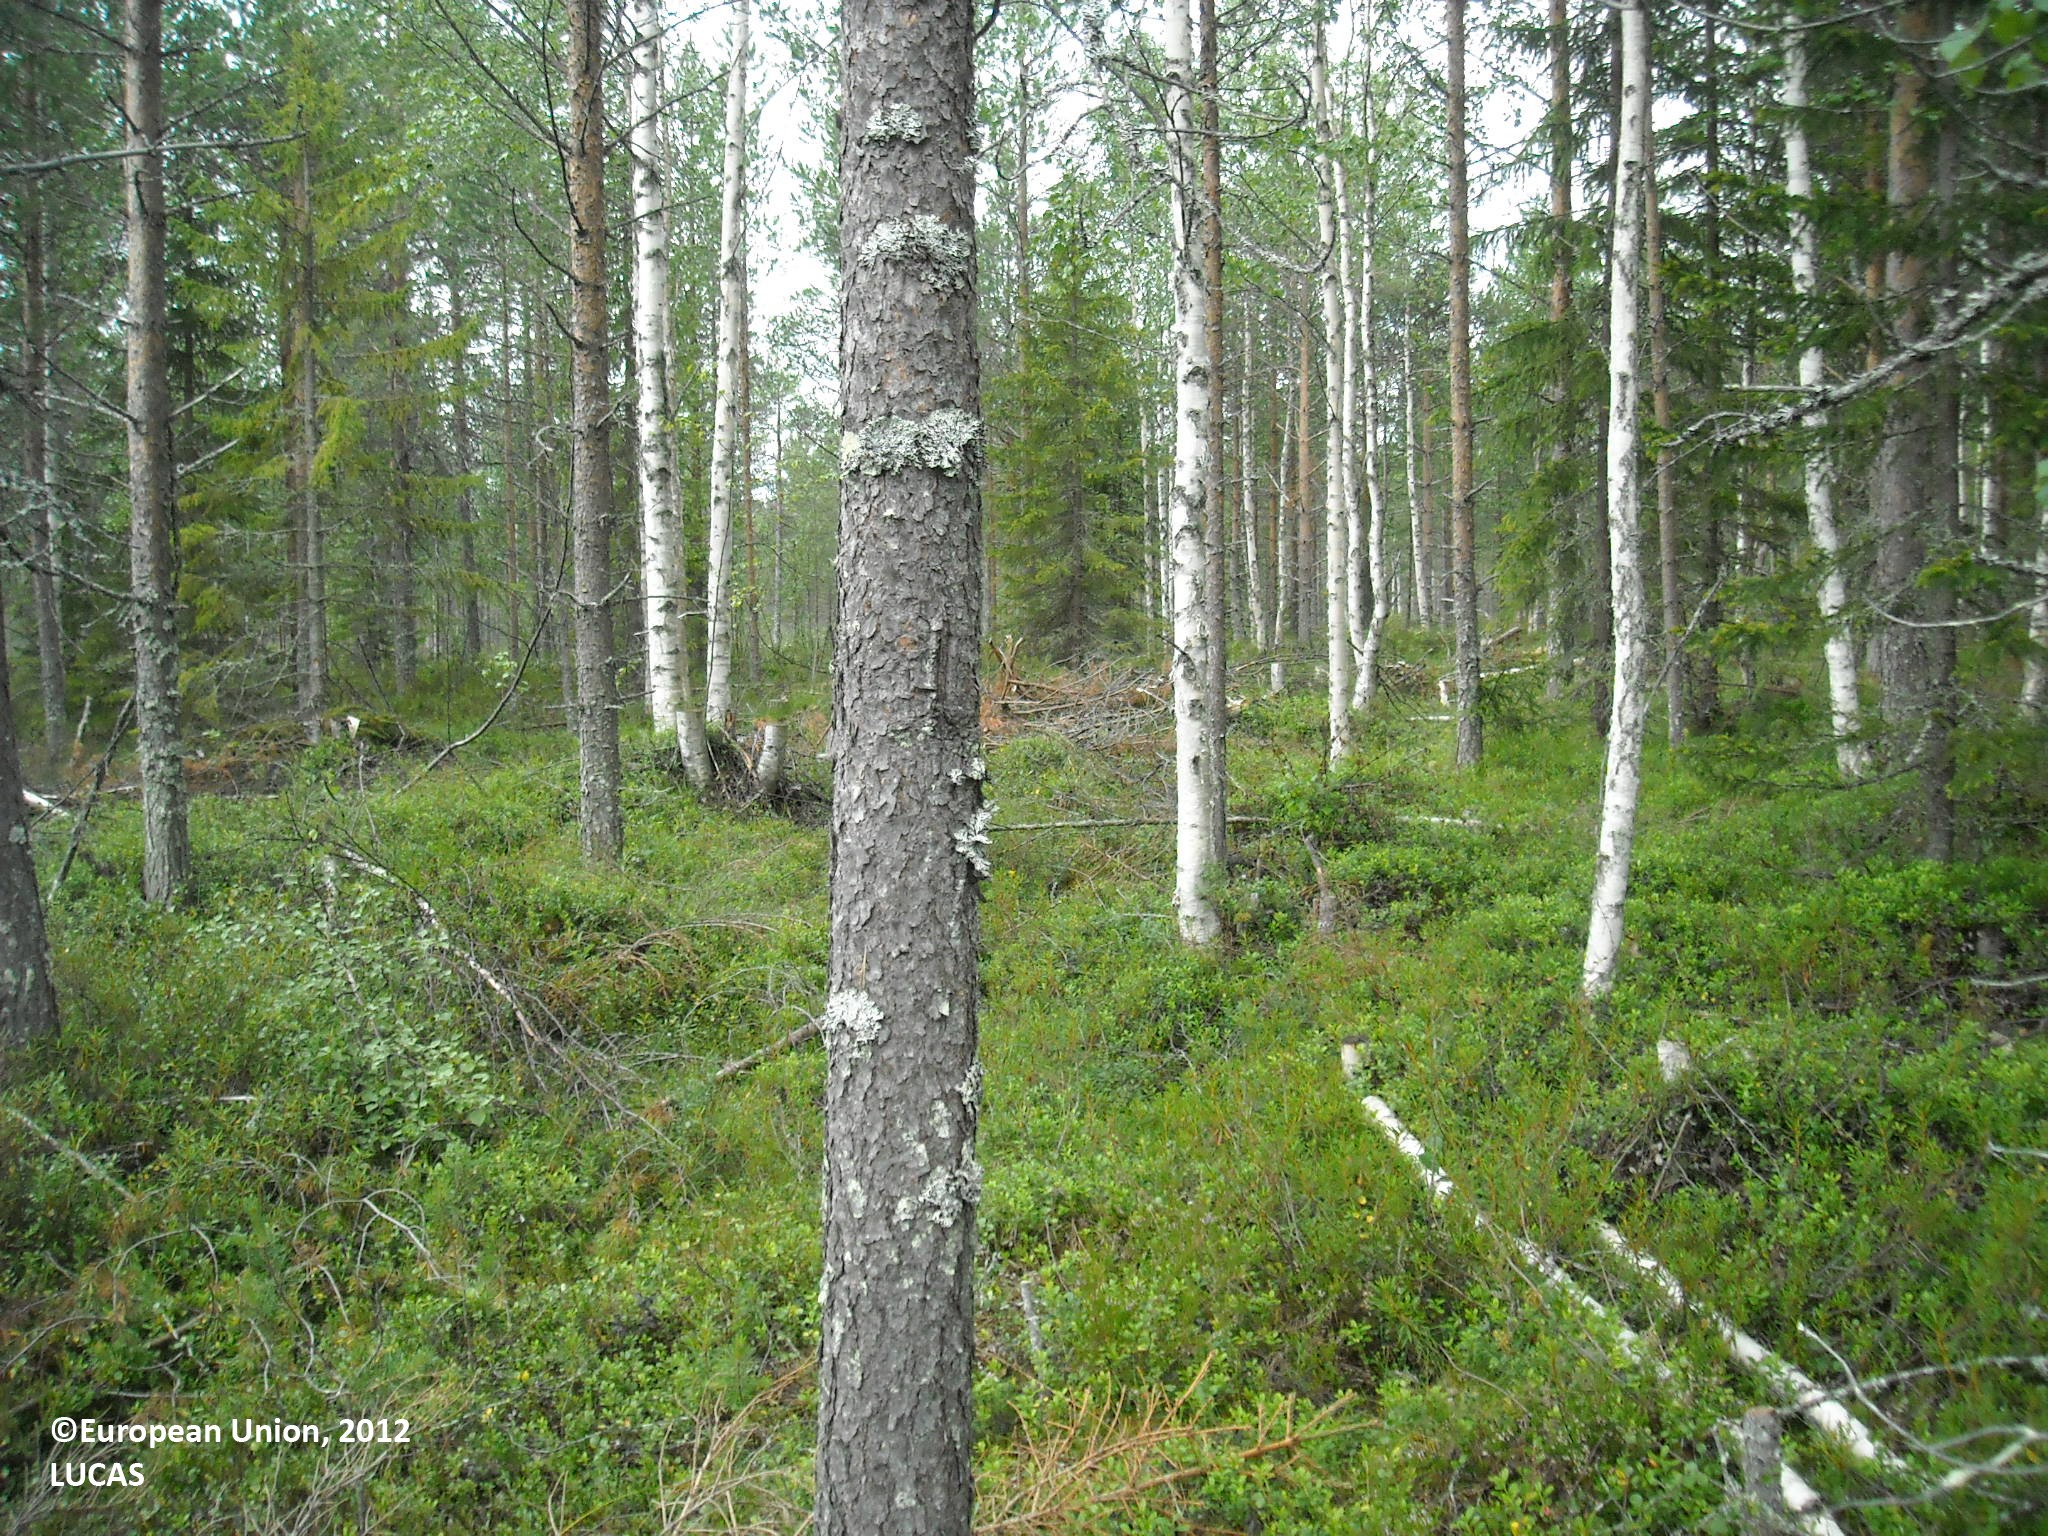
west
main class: Woodland
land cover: Pine dominated mixed woodland
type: mire and swamp forests
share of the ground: 50 - 75 %
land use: Forestry
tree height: > 5 m
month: July
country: FI
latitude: 64.9646
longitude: 27.6127
